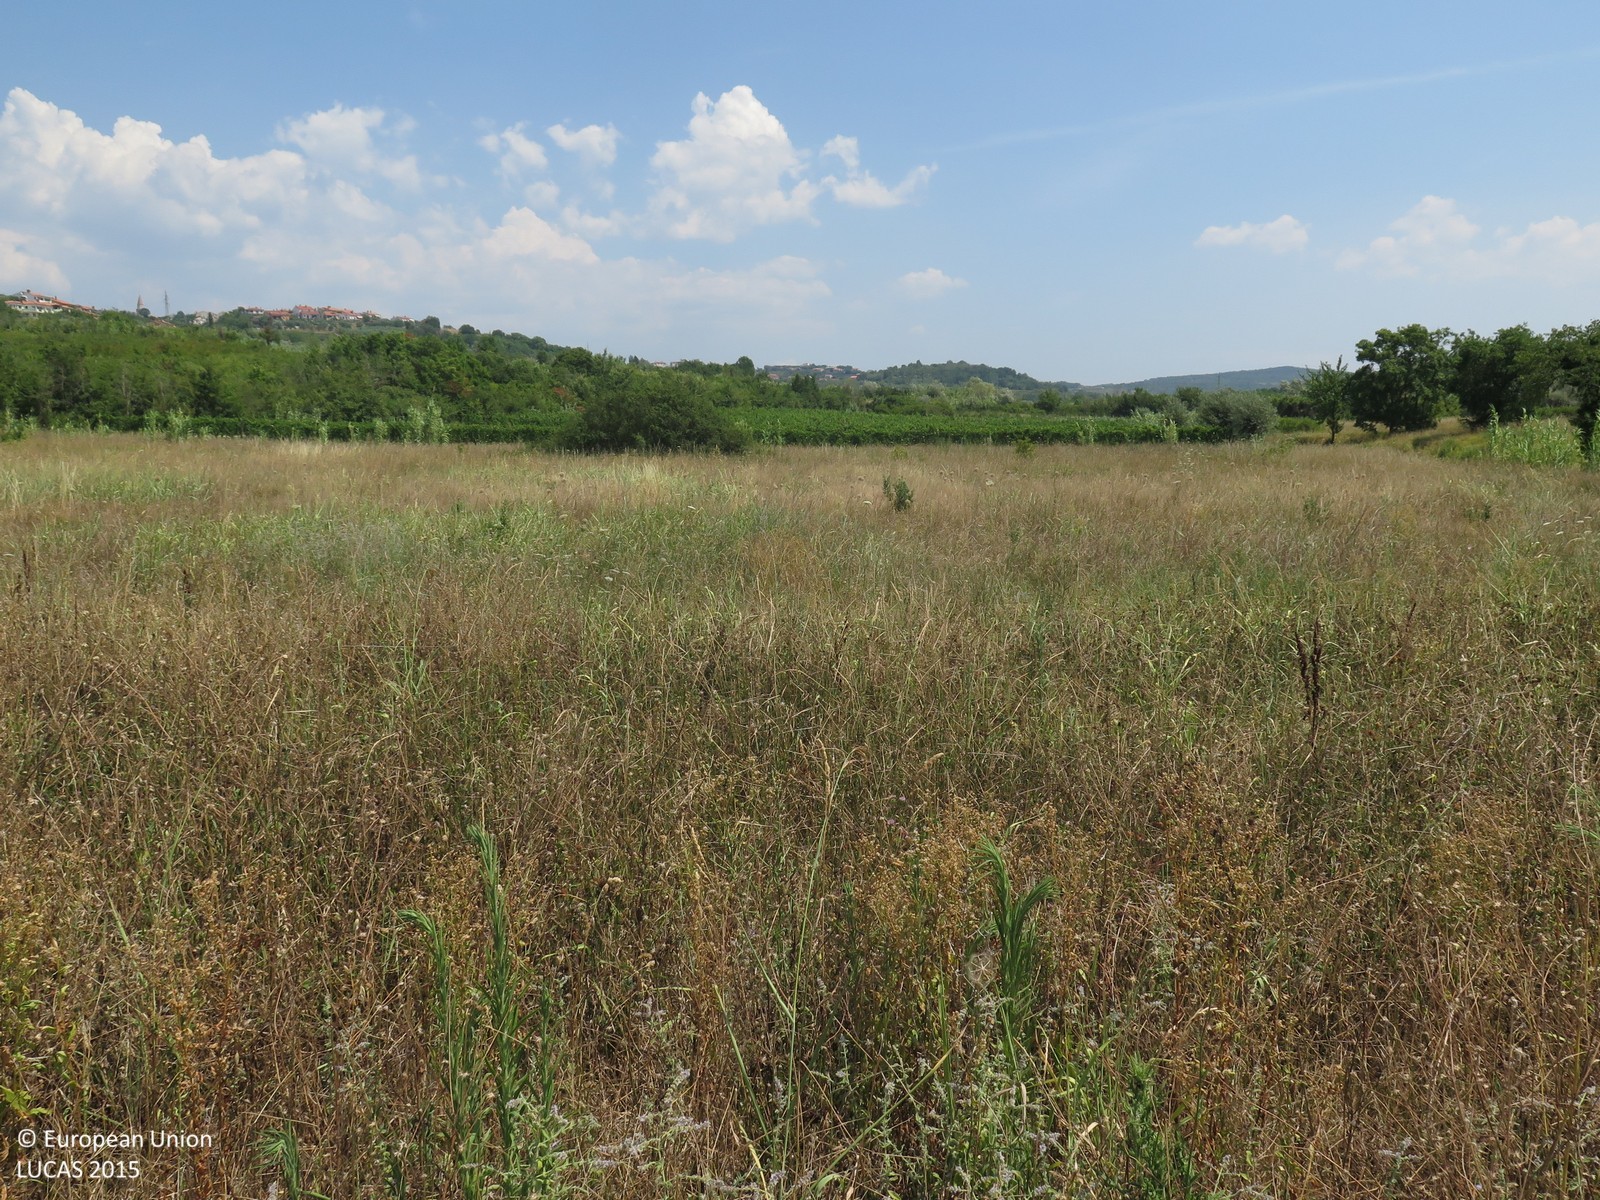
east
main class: Grassland
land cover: Spontaneously vegetated surfaces
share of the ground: > 75 %
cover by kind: herbaceous plants 95 %, shrubs 5 %
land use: Fallow land
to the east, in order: Spontaneously vegetated surfaces; Tracks; Spontaneously vegetated surfaces; Single bushes/trees; Spontaneously vegetated surfaces; Ditches and canals; Spontaneously vegetated surfaces; Tracks; Vineyards; Spontaneously vegetated surfaces; Ditches and canals; Vineyards; Grass margins; Tracks; Ditches and canals; Broadleaved woodland
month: July
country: HR
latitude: 45.4057
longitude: 13.6365
